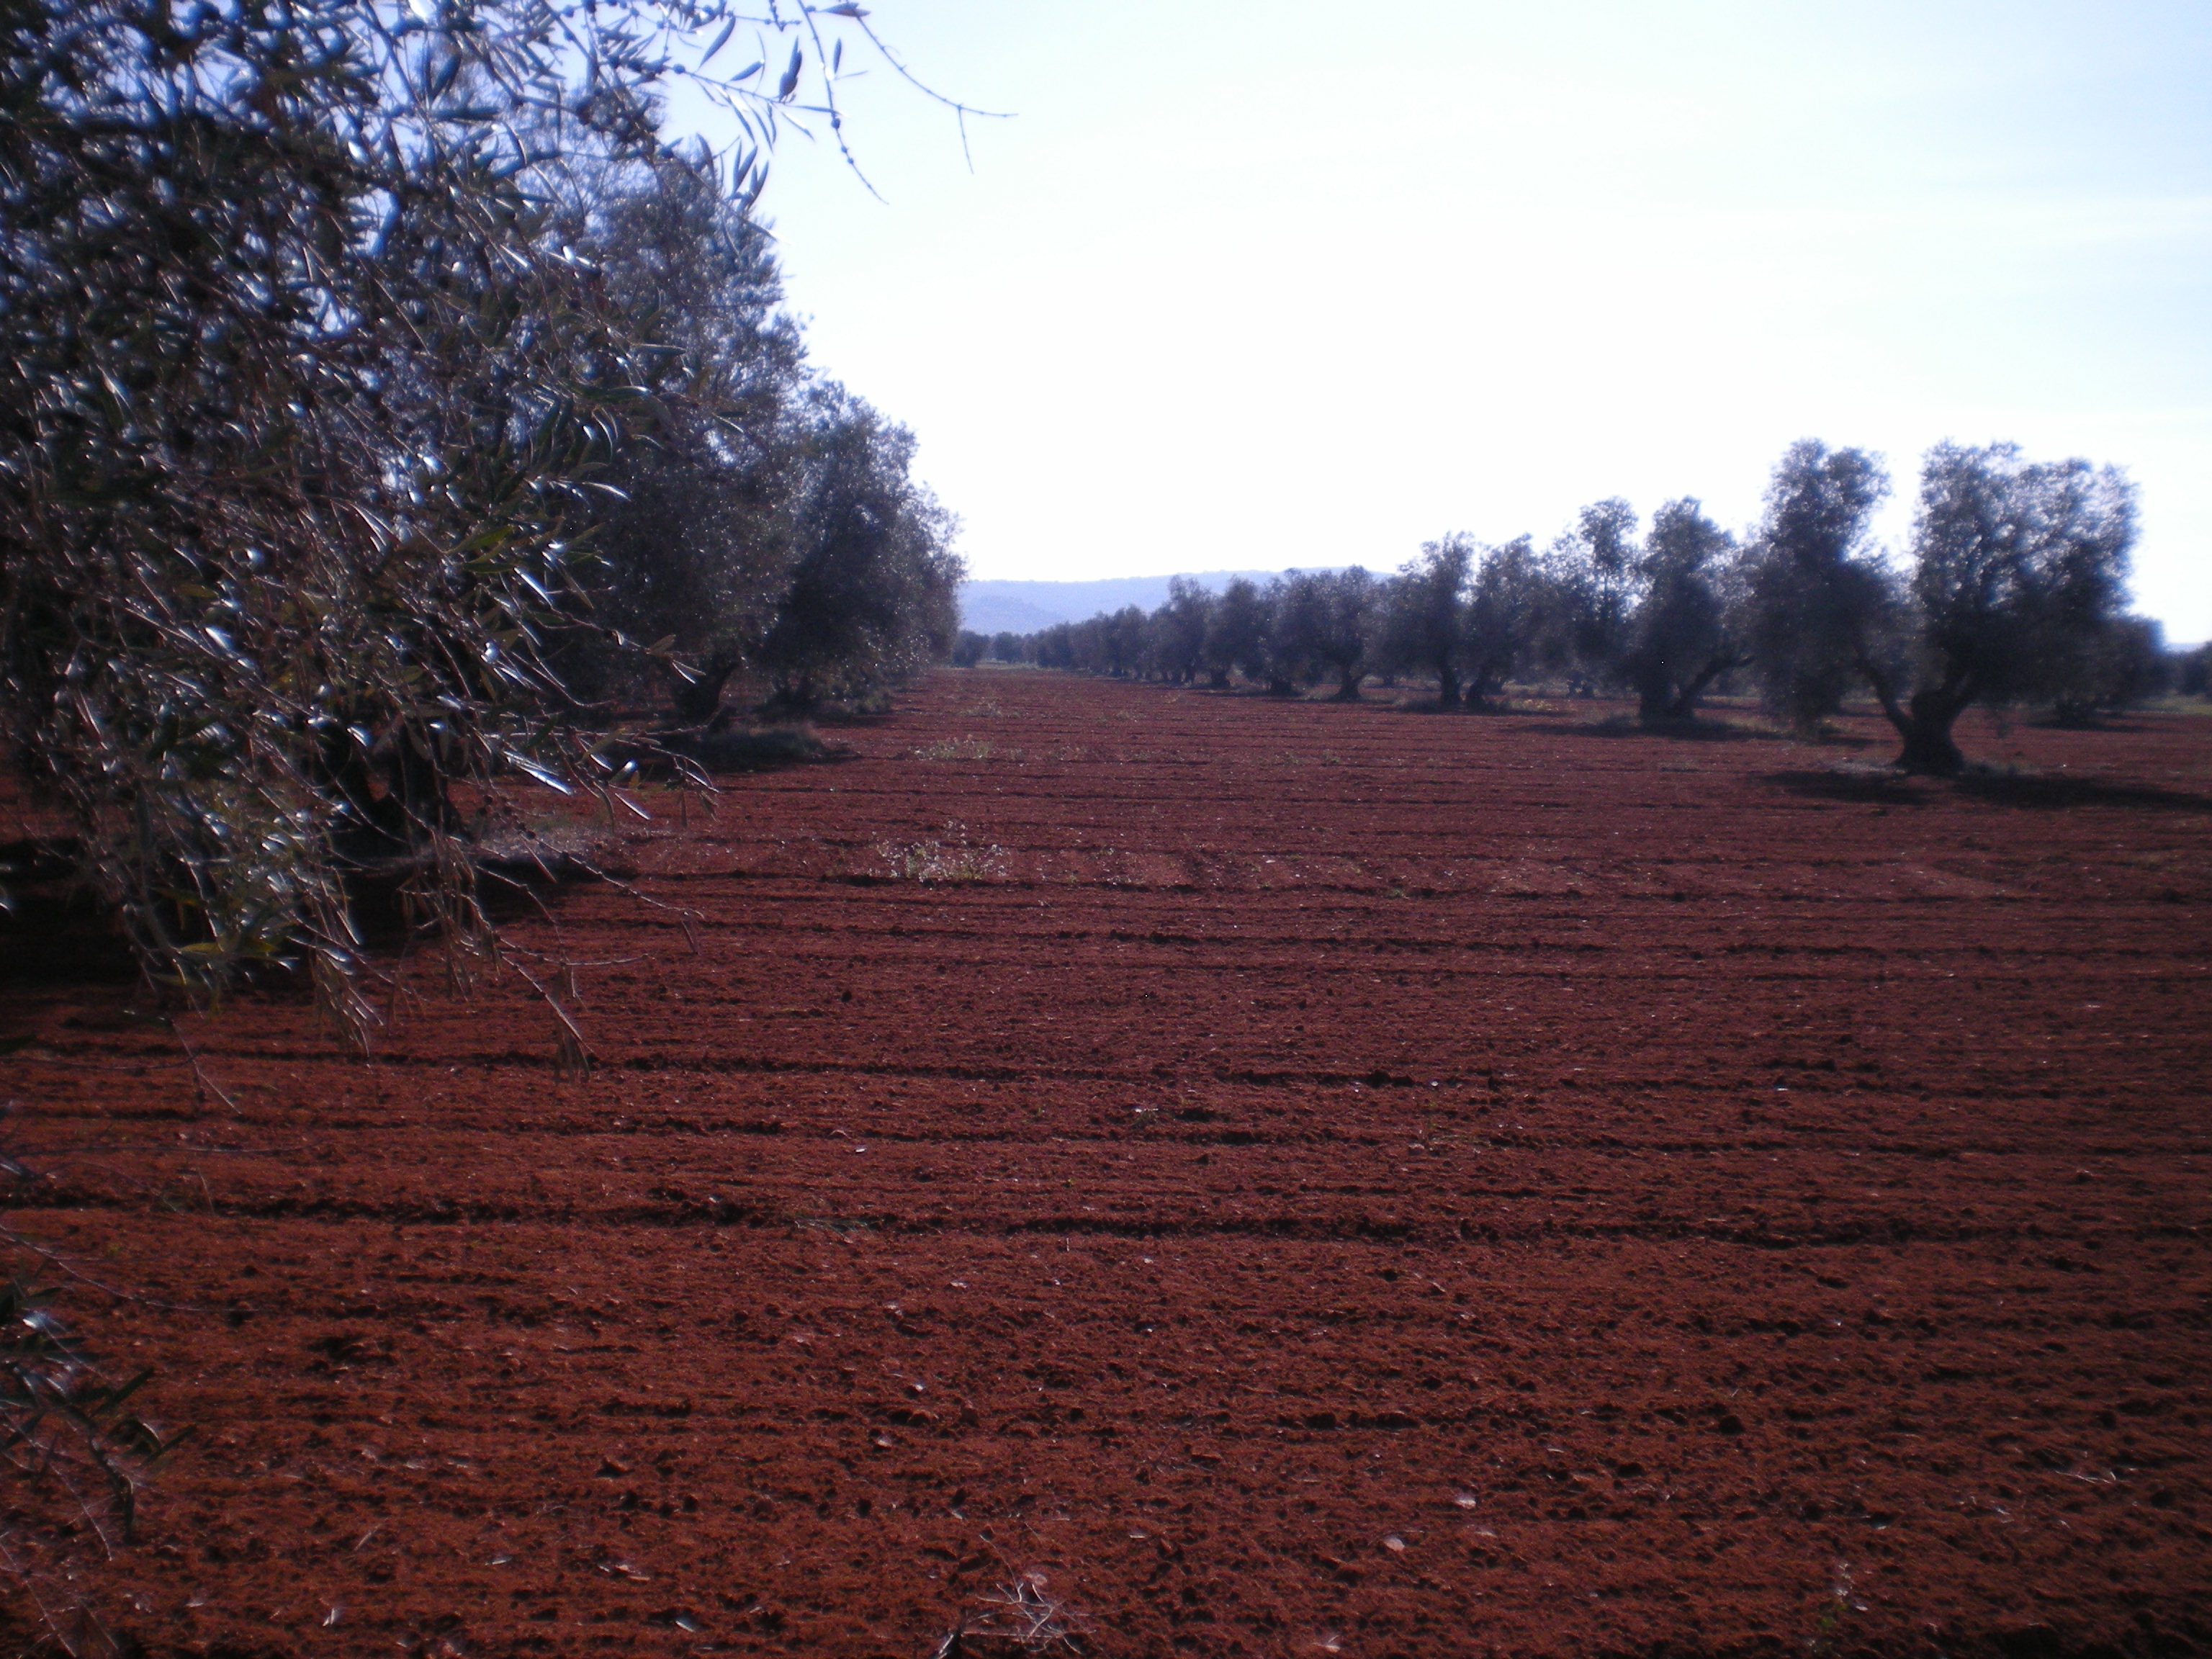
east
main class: Cropland
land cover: Olive groves
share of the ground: 10 - 25 %
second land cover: Other bare soil
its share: > 75 %
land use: Agriculture (excluding fallow land and kitchen gardens)
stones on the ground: < 10 %
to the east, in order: Olive groves; Other bare soil
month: April
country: ES
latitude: 38.9105
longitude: -3.6121
